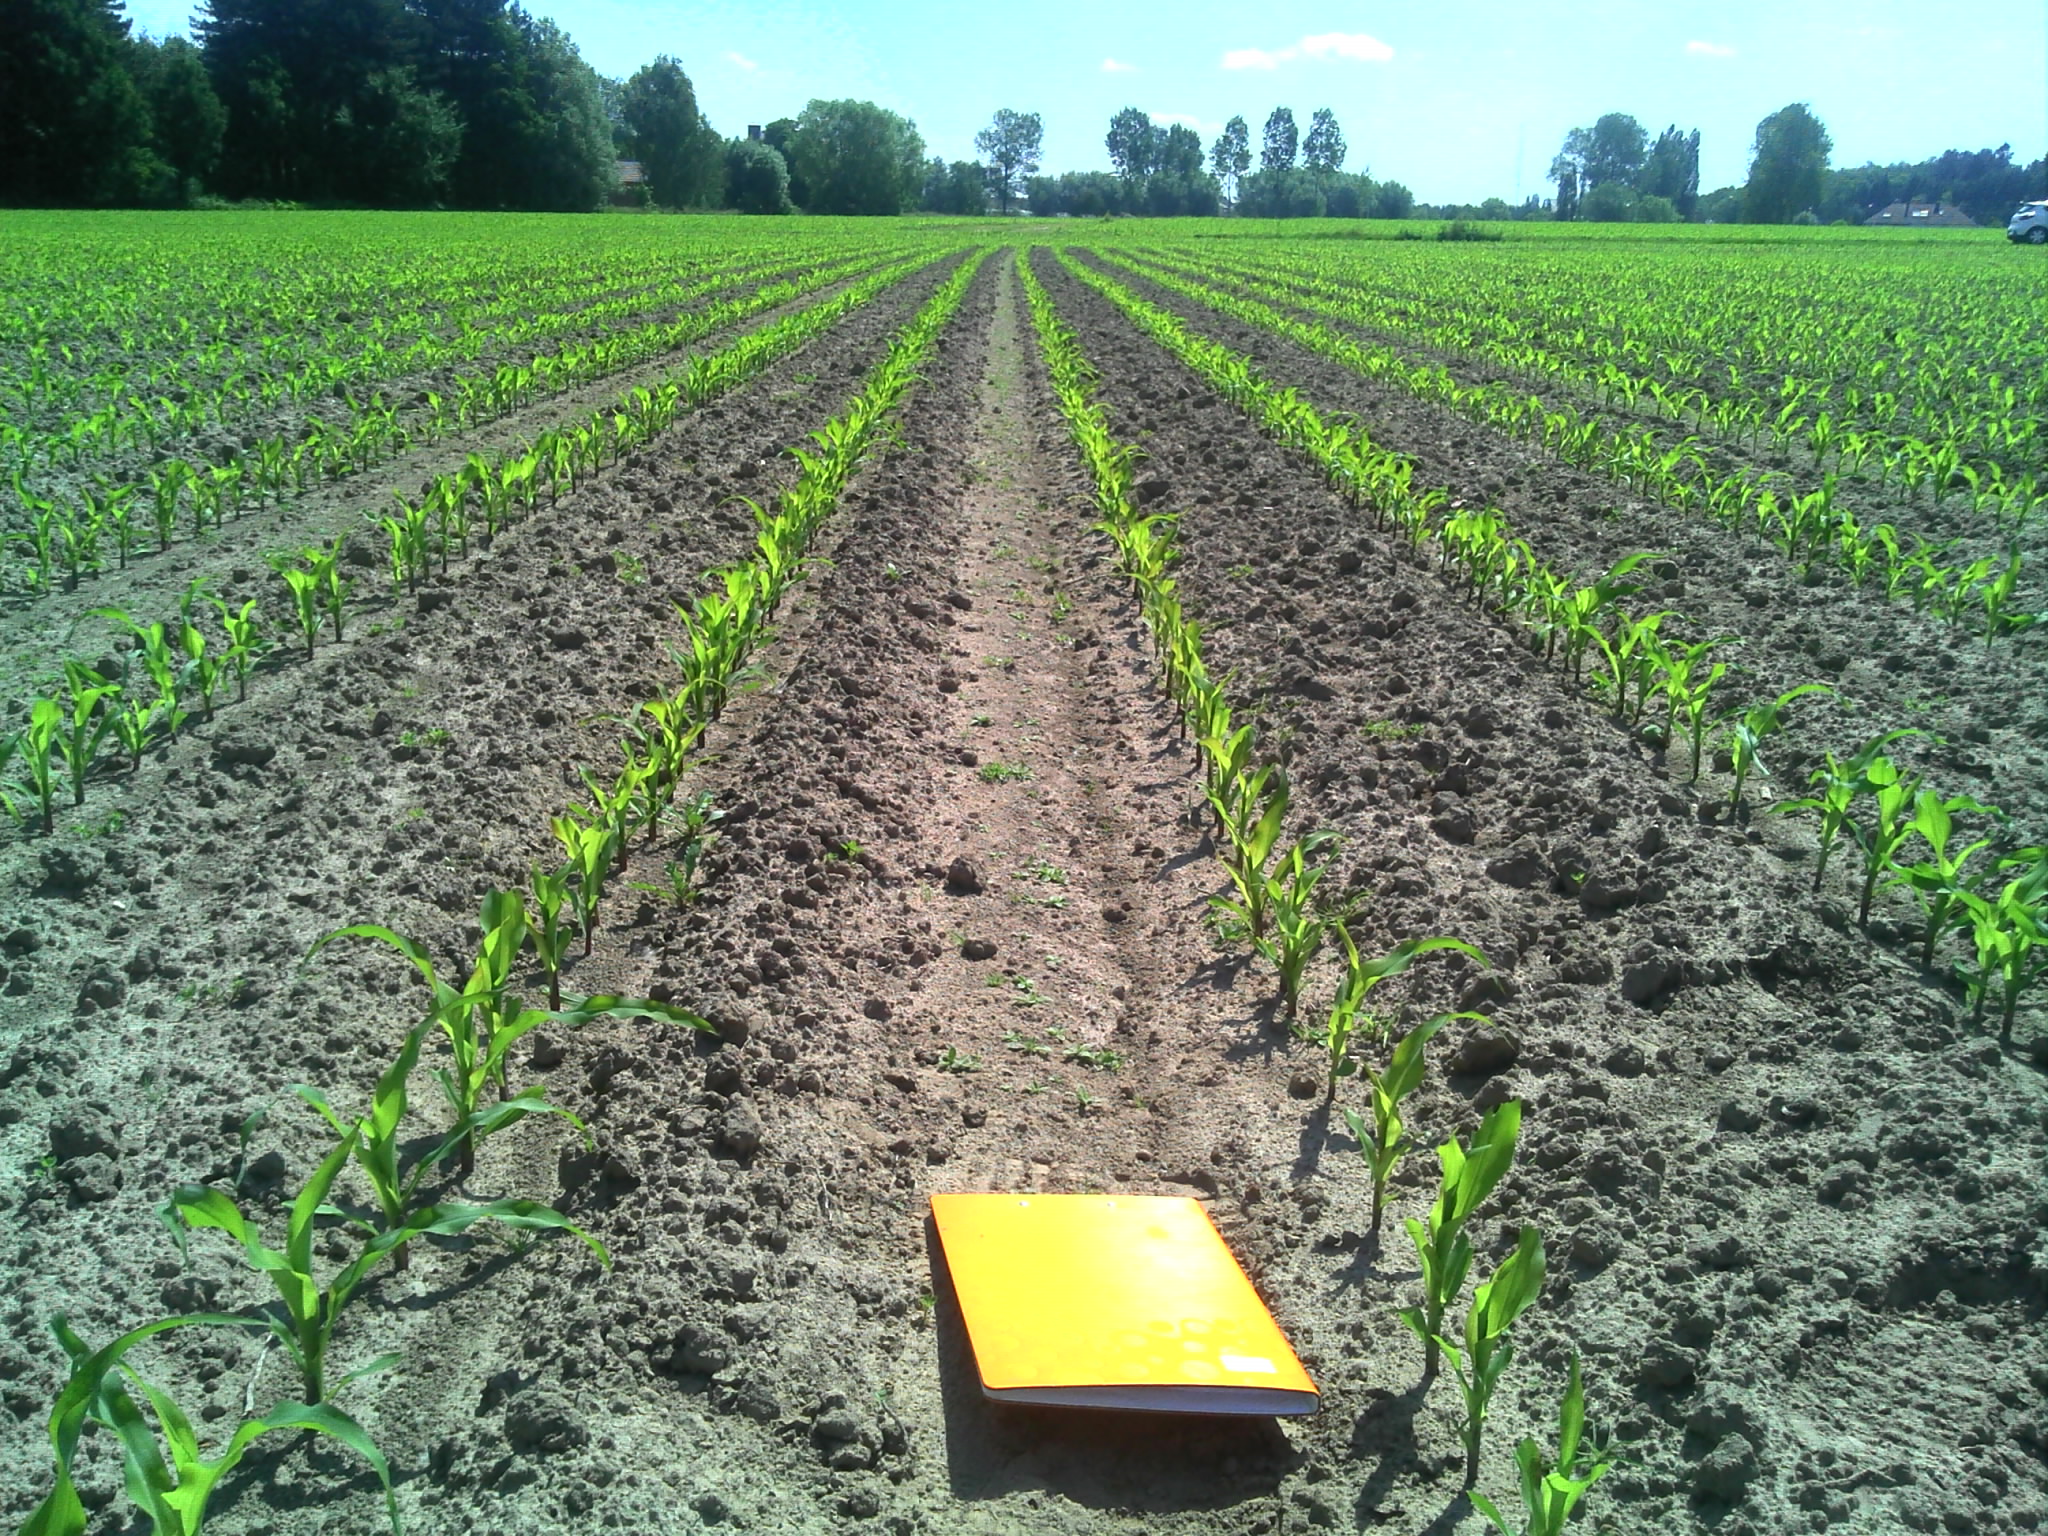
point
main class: Cropland
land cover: Maize
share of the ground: 10 - 25 %
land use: Agriculture (excluding fallow land and kitchen gardens)
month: June
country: BE
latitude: 51.0140
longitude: 4.2792
